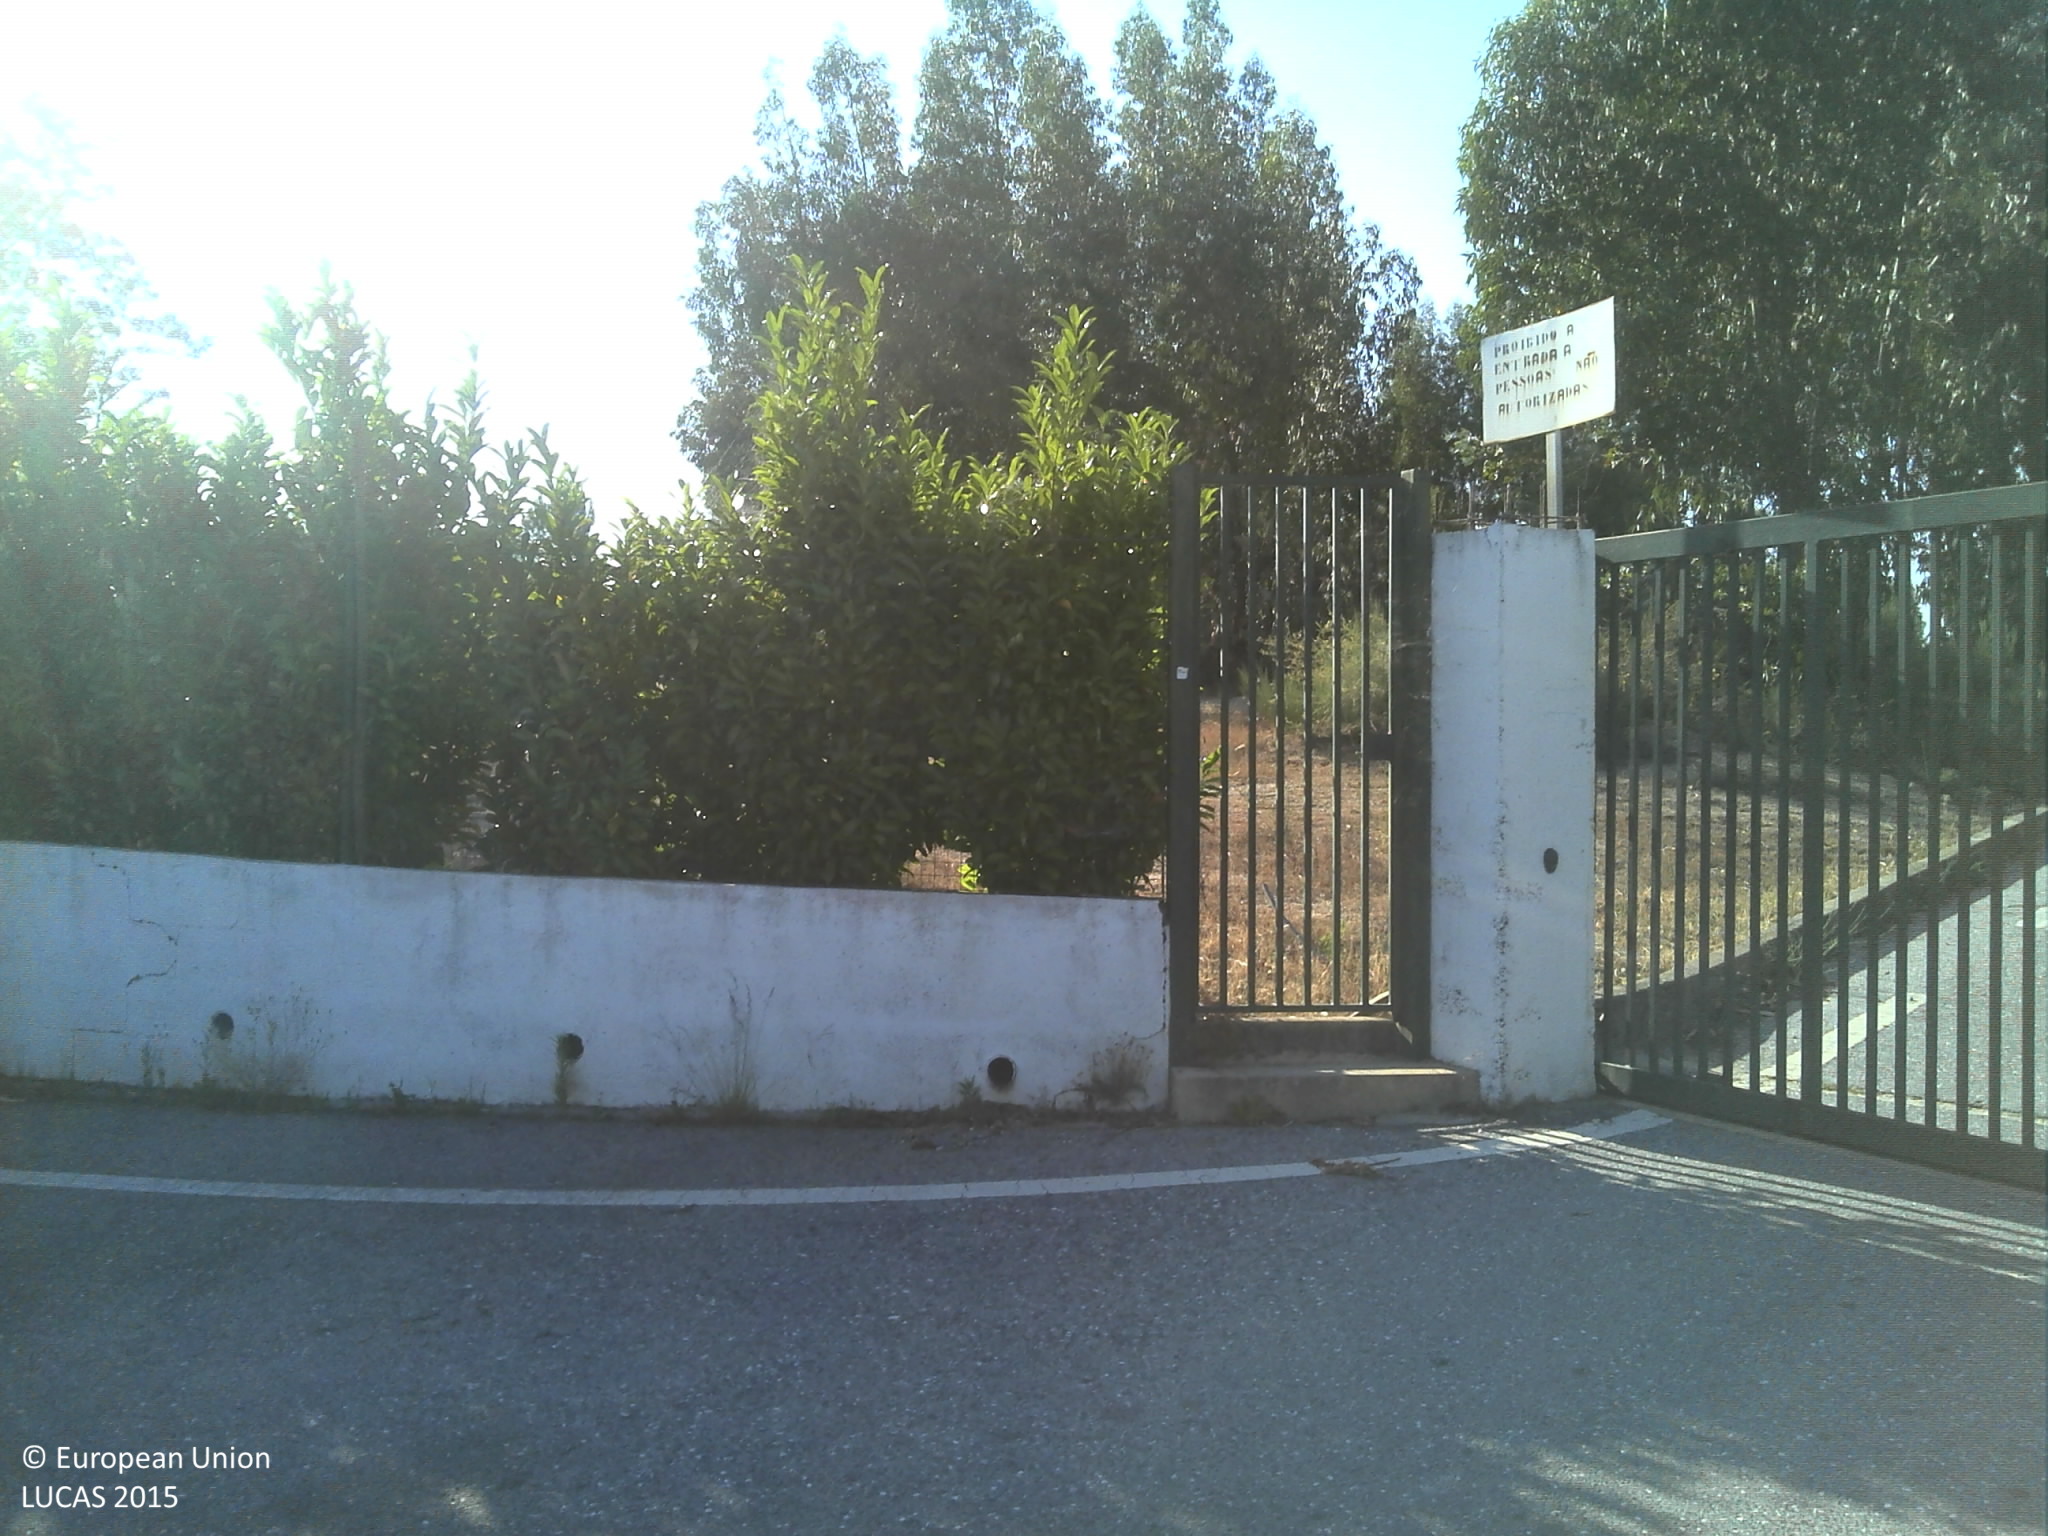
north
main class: Woodland
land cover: Broadleaved woodland
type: broadleaved evergreen forest
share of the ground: 25 - 50 %
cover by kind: broadleaved forest trees 40 %, unconsolidated bare surface 40 %, herbaceous plants 20 %
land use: Forestry
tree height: > 5 m
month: June
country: PT
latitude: 39.9519
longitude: -7.4111
